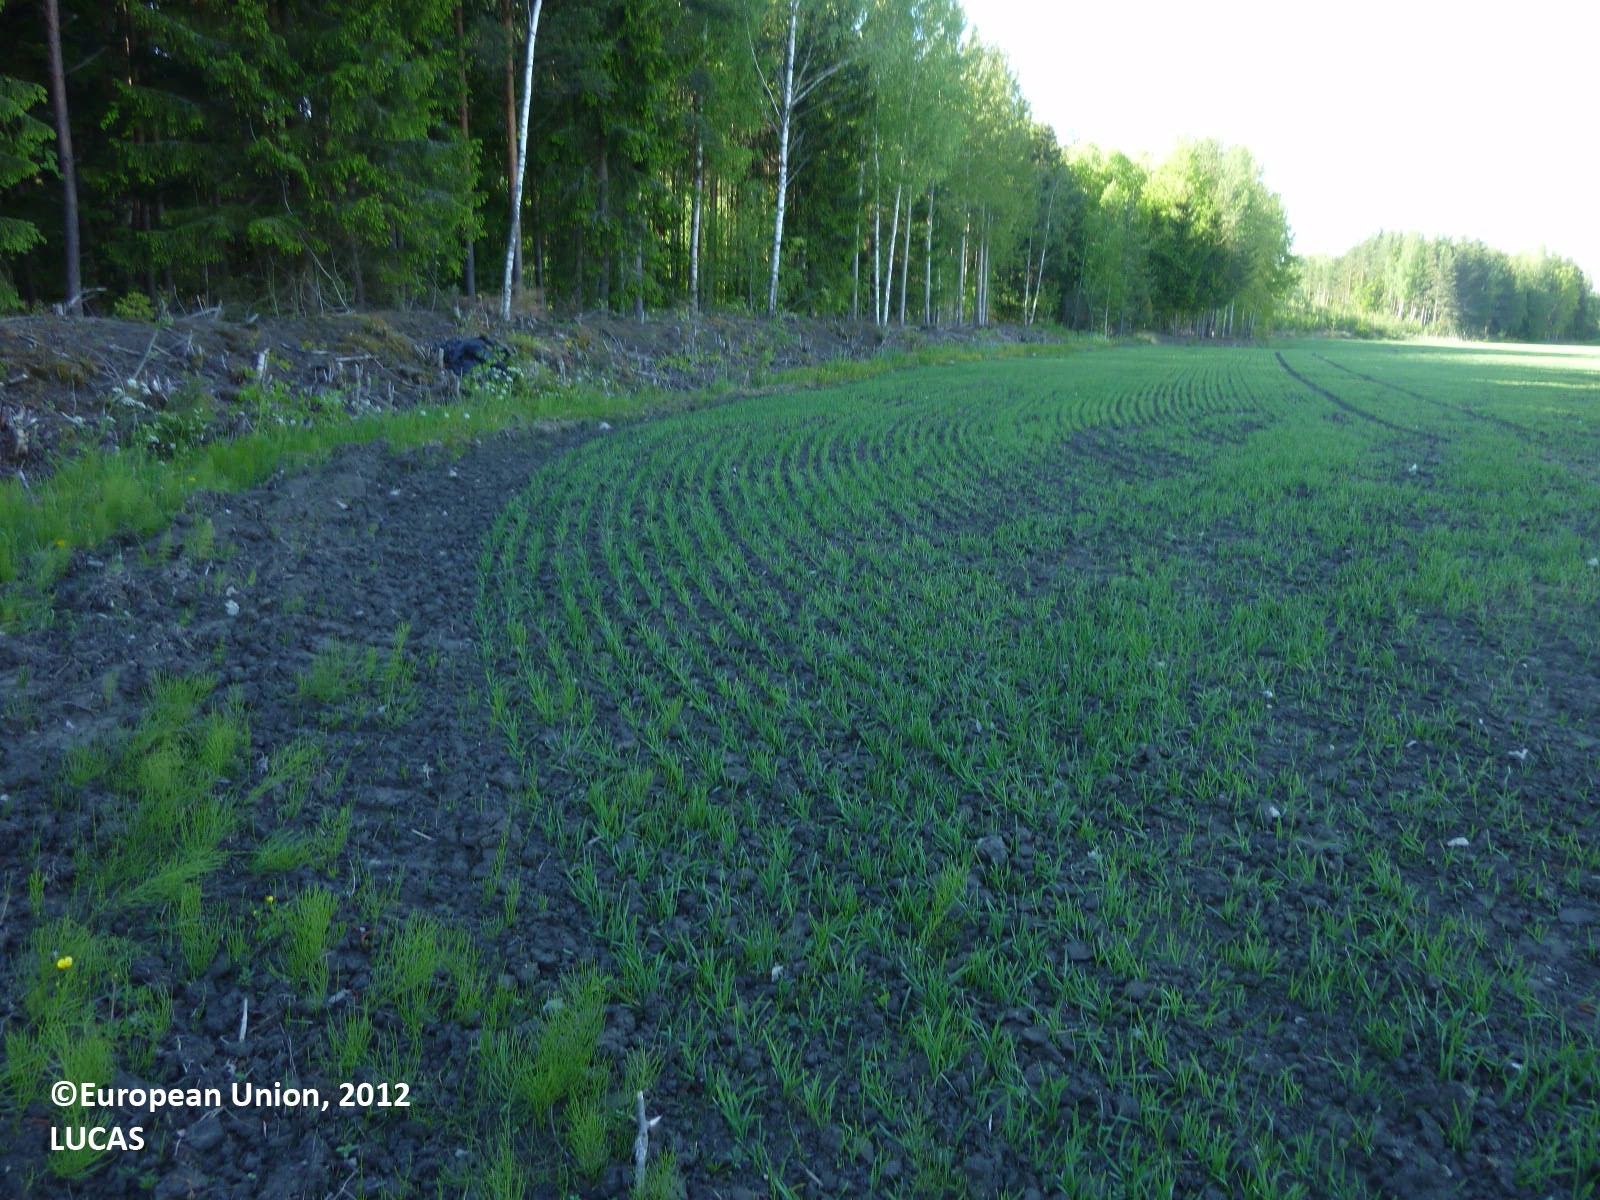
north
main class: Cropland
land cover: Common wheat
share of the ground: > 75 %
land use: Agriculture (excluding fallow land and kitchen gardens)
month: June
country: FI
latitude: 60.3377
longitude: 22.6637
